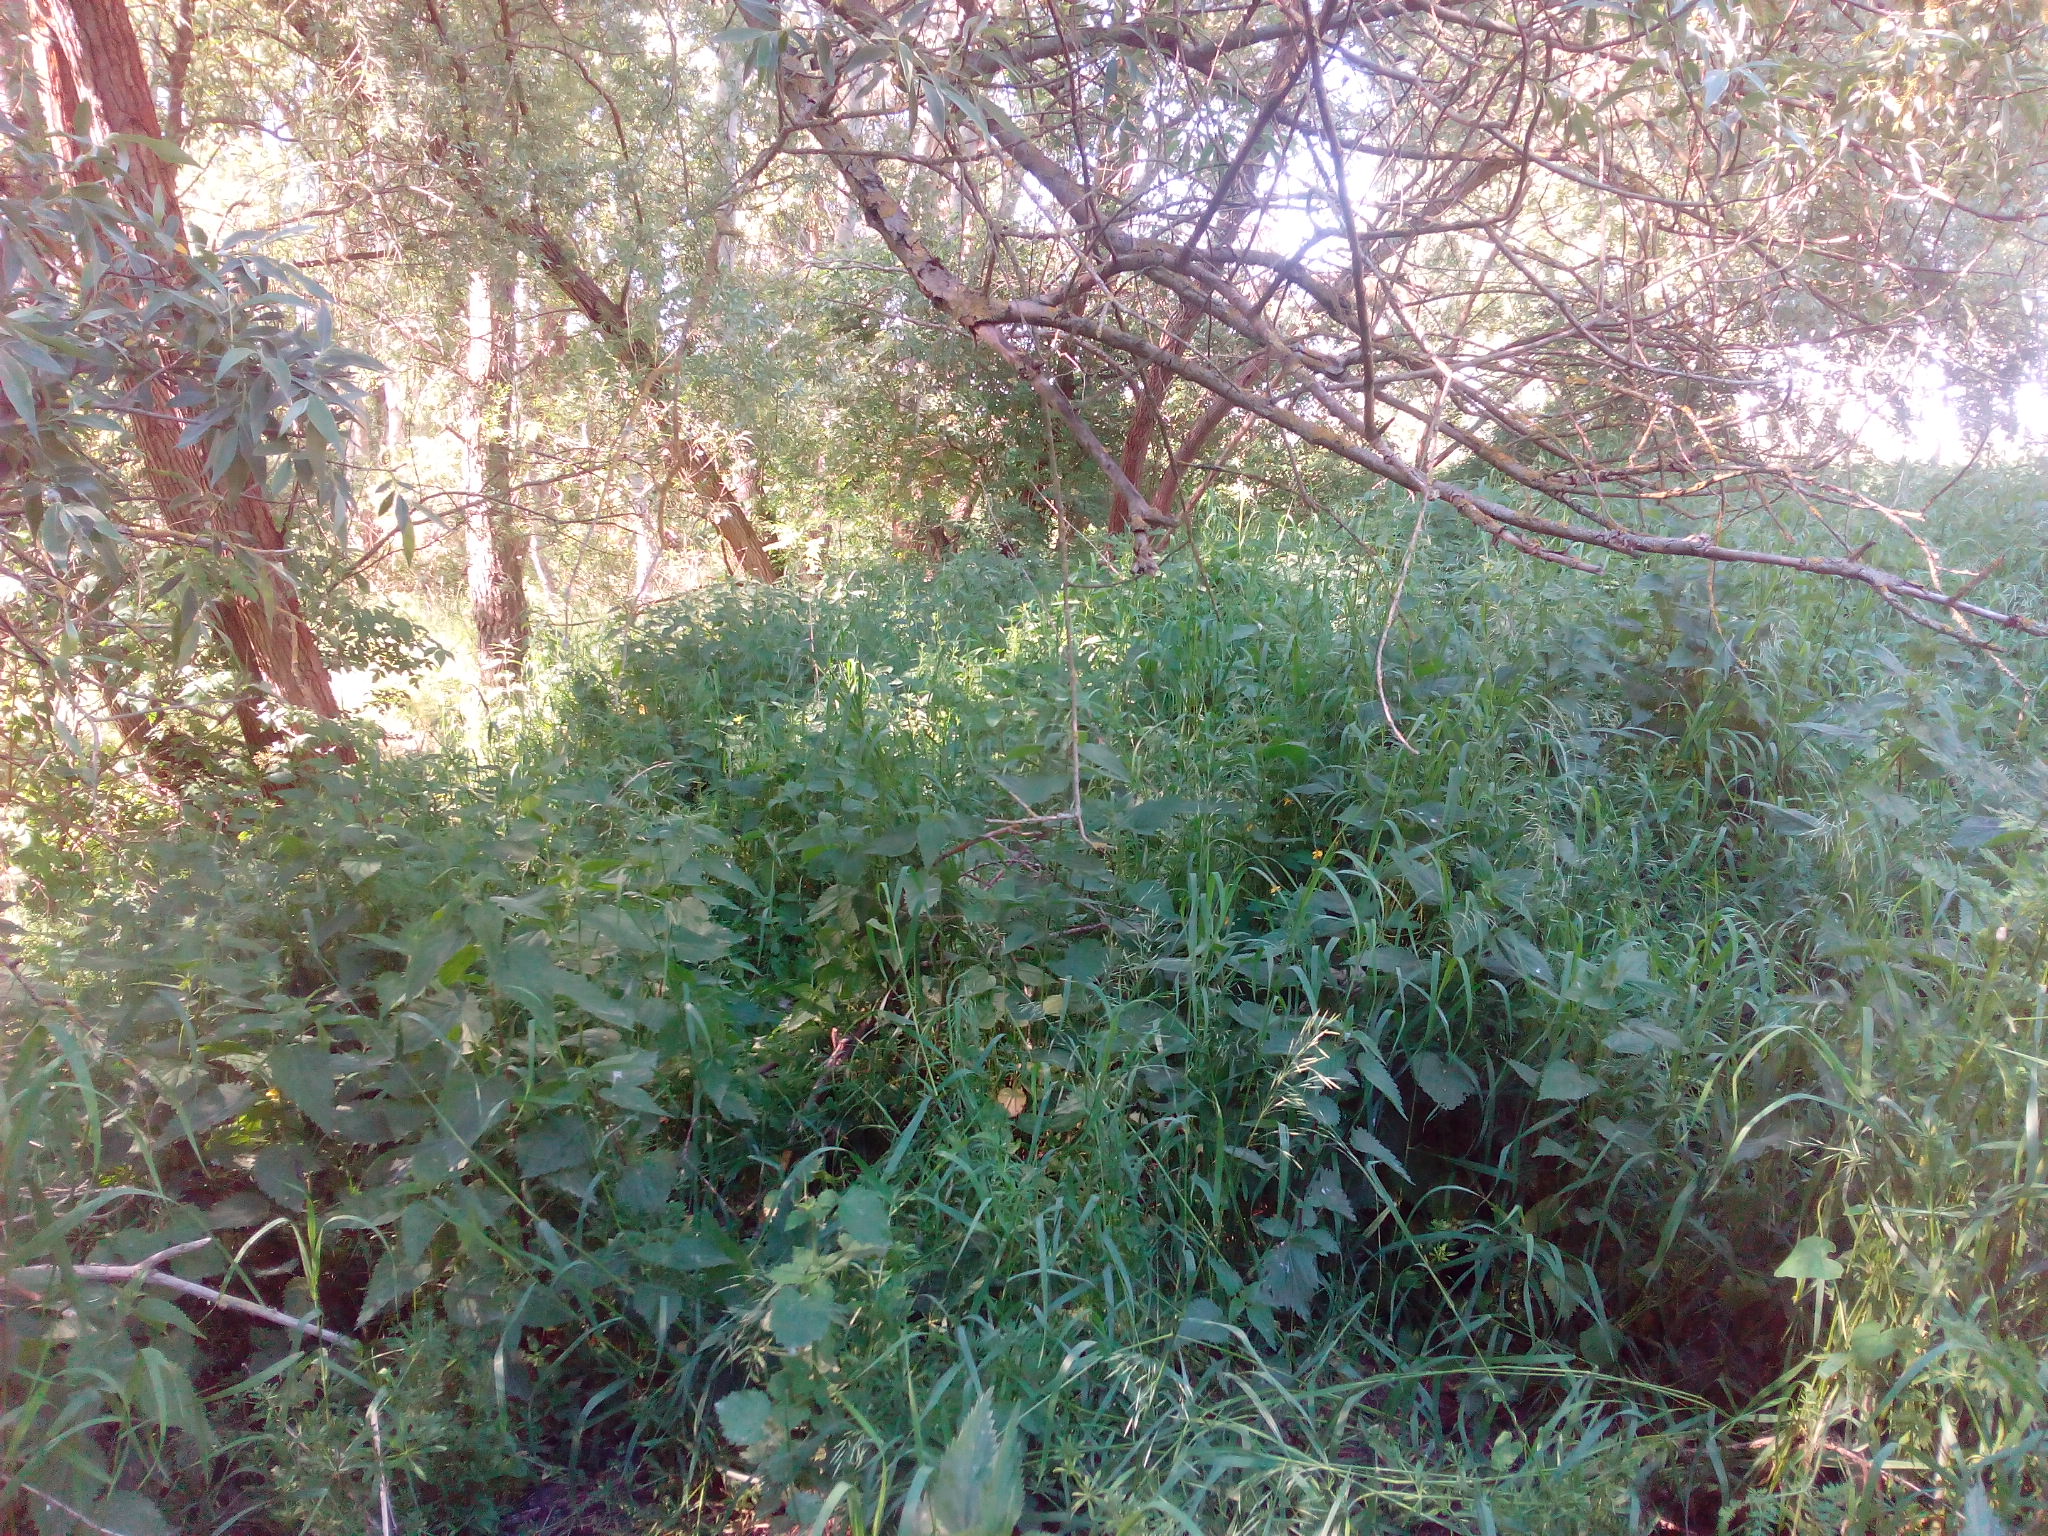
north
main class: Woodland
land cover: Broadleaved woodland
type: mesophytic deciduous forest
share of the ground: 25 - 50 %
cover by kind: broadleaved forest trees 40 %, herbaceous plants 30 %, shrubs 20 %, coniferous forest trees 10 %
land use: Forestry
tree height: > 5 m
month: June
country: DE
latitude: 53.1322
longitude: 14.1708
